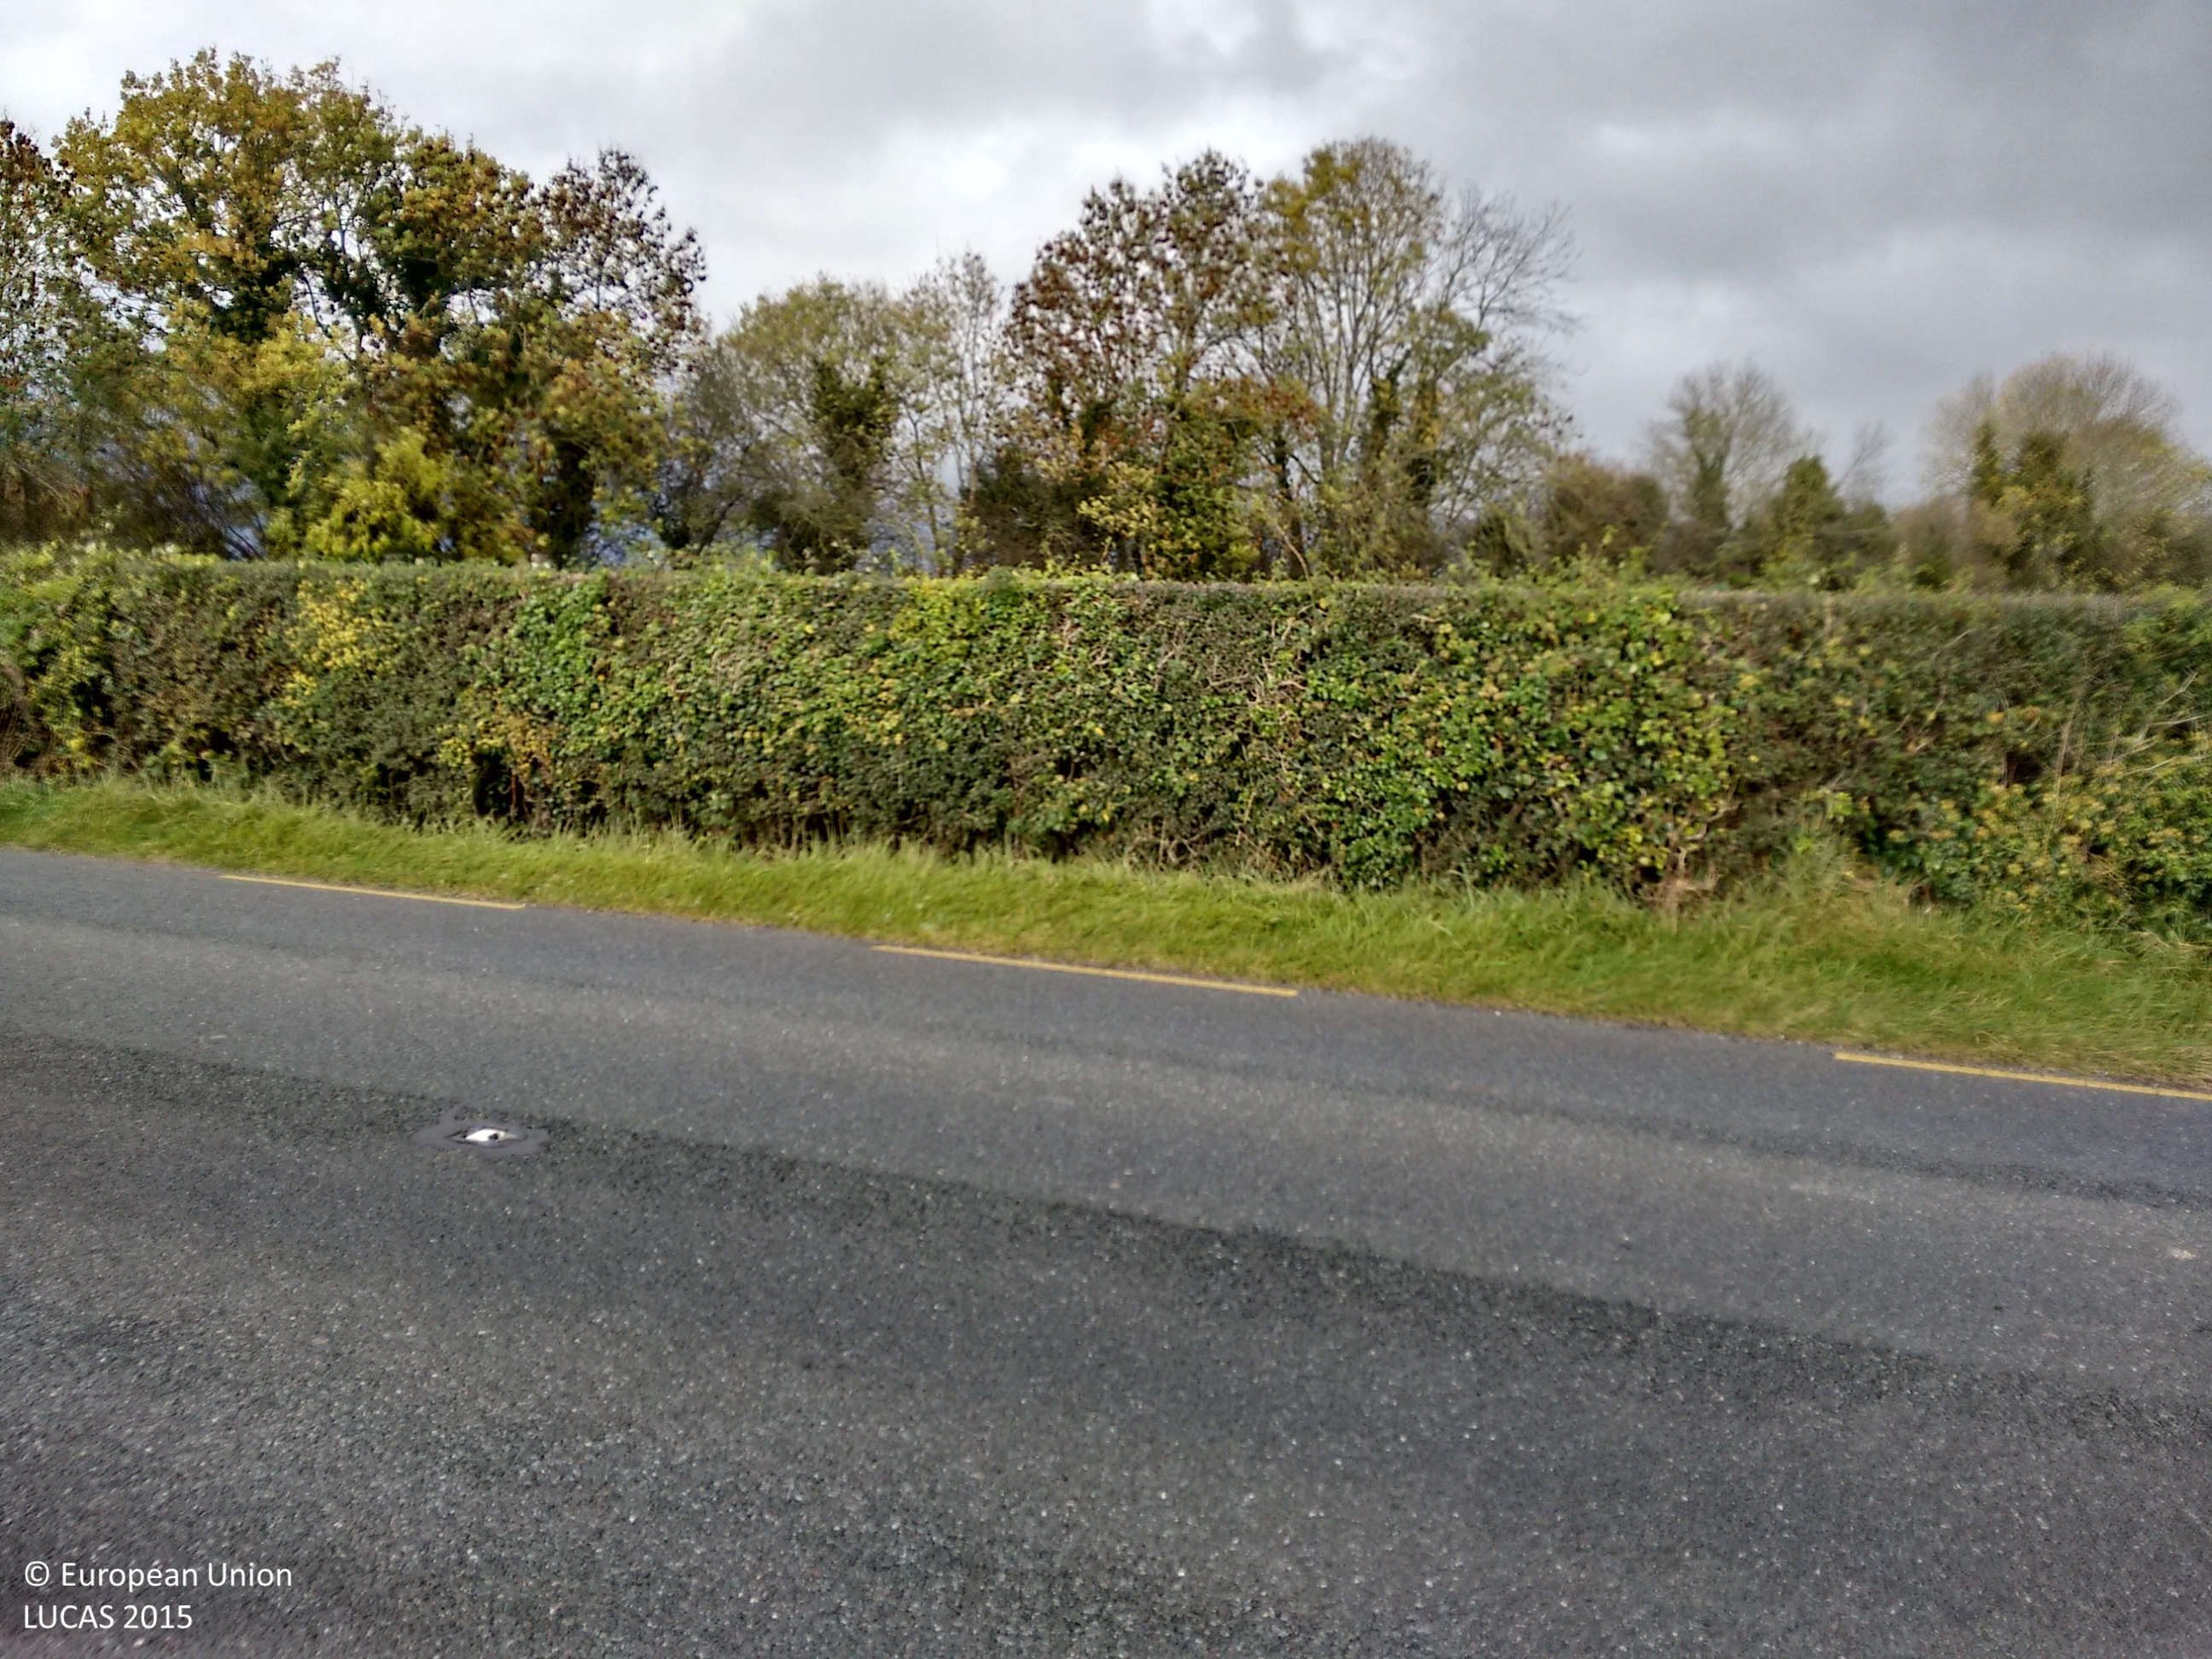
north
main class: Grassland
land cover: Grassland without tree/shrub cover
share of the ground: > 75 %
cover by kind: herbaceous plants 95 %, shrubs 5 %
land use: Agriculture (excluding fallow land and kitchen gardens)
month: October
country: IE
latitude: 53.2335
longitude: -7.6468
